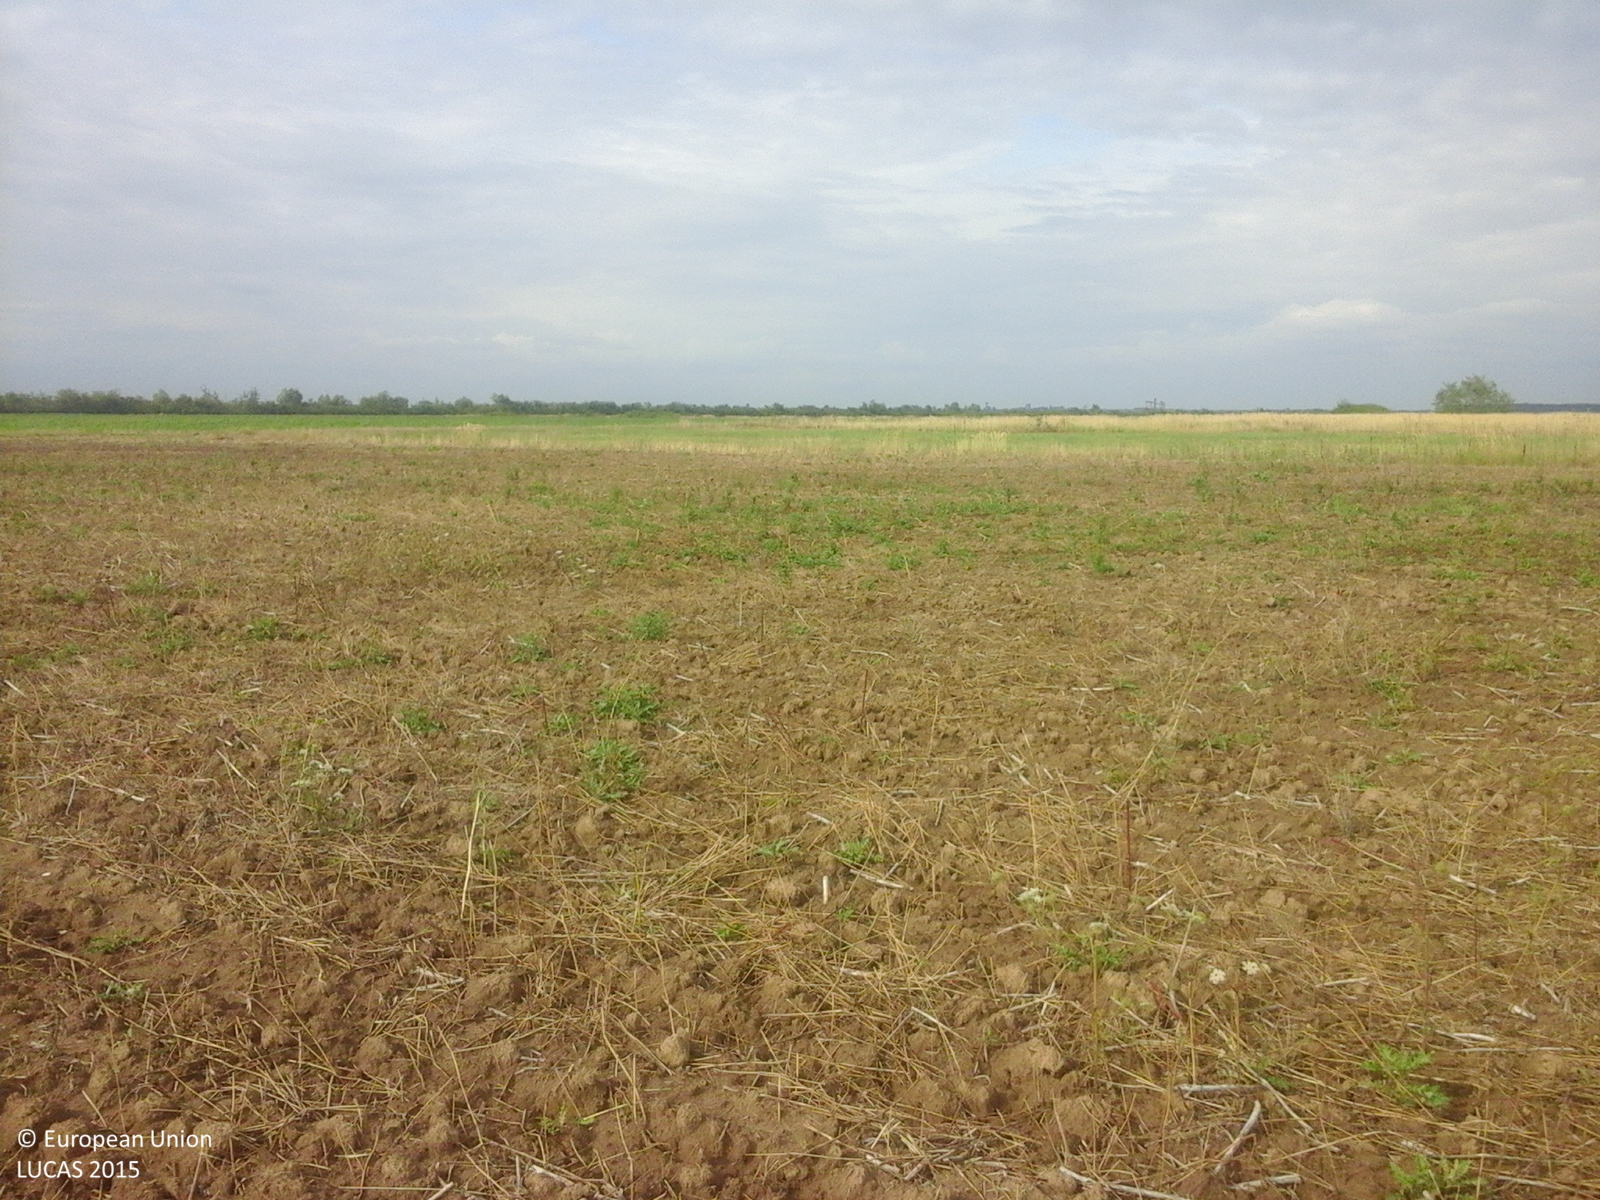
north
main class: Cropland
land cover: Rape and turnip rape
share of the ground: < 10 %
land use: Agriculture (excluding fallow land and kitchen gardens)
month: August
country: RO
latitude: 45.3887
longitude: 21.2816
